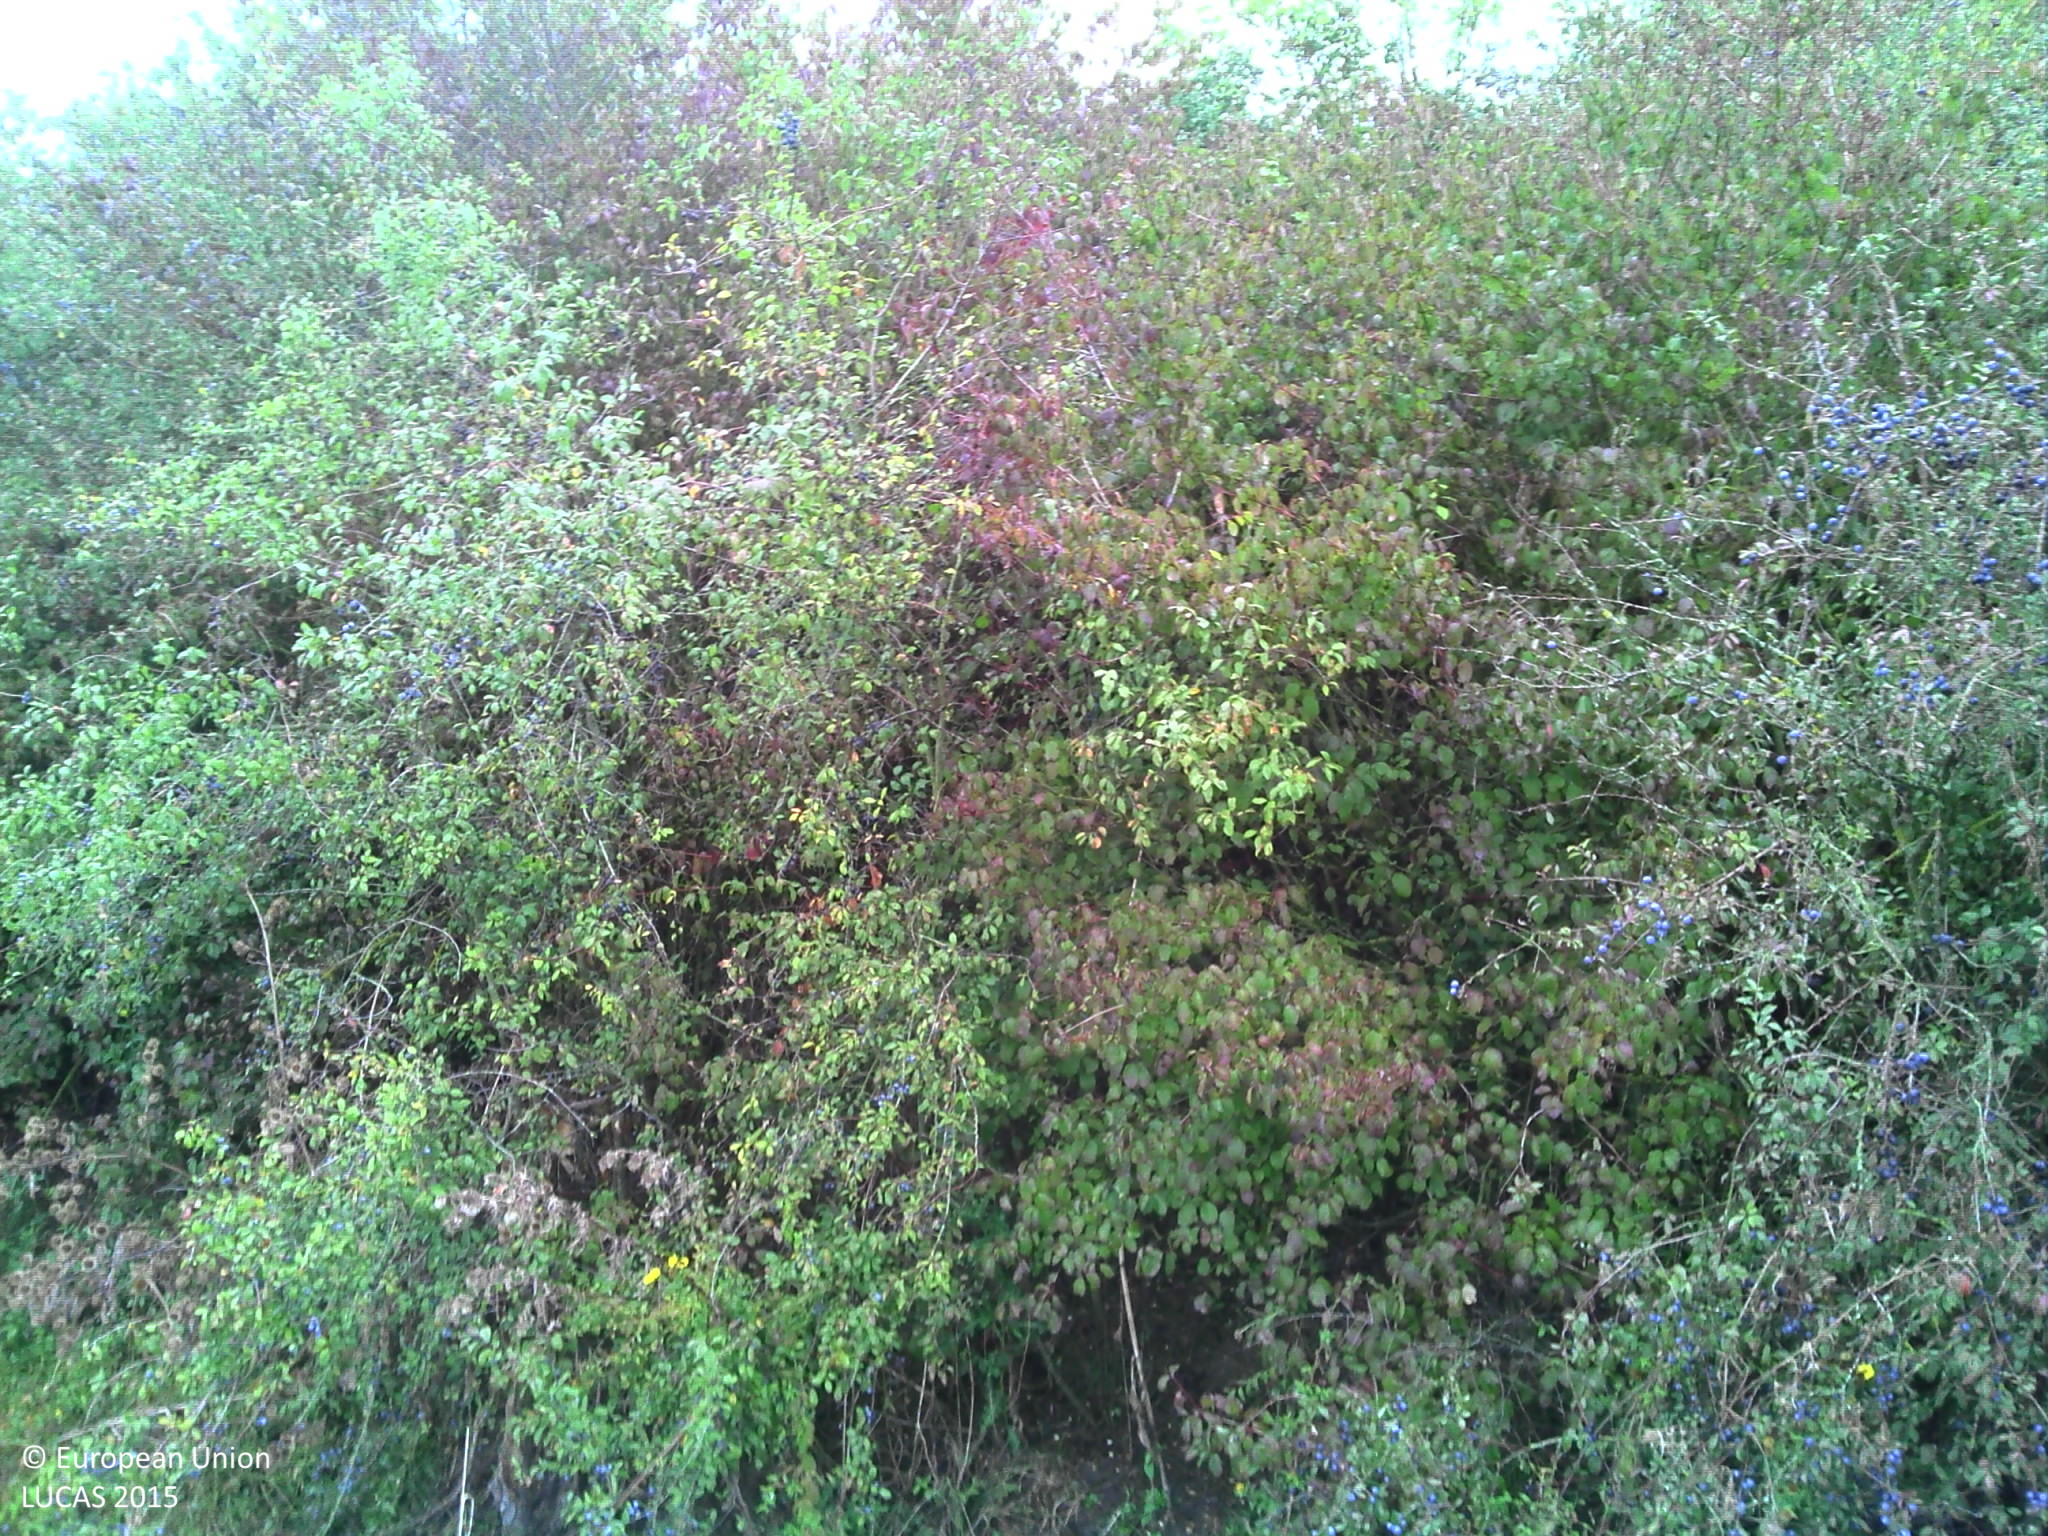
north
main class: Grassland
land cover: Grassland without tree/shrub cover
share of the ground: > 75 %
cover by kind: herbaceous plants 100 %
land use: Agriculture (excluding fallow land and kitchen gardens)
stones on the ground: < 10 %
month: October
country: FR
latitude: 48.2702
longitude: 4.2169
